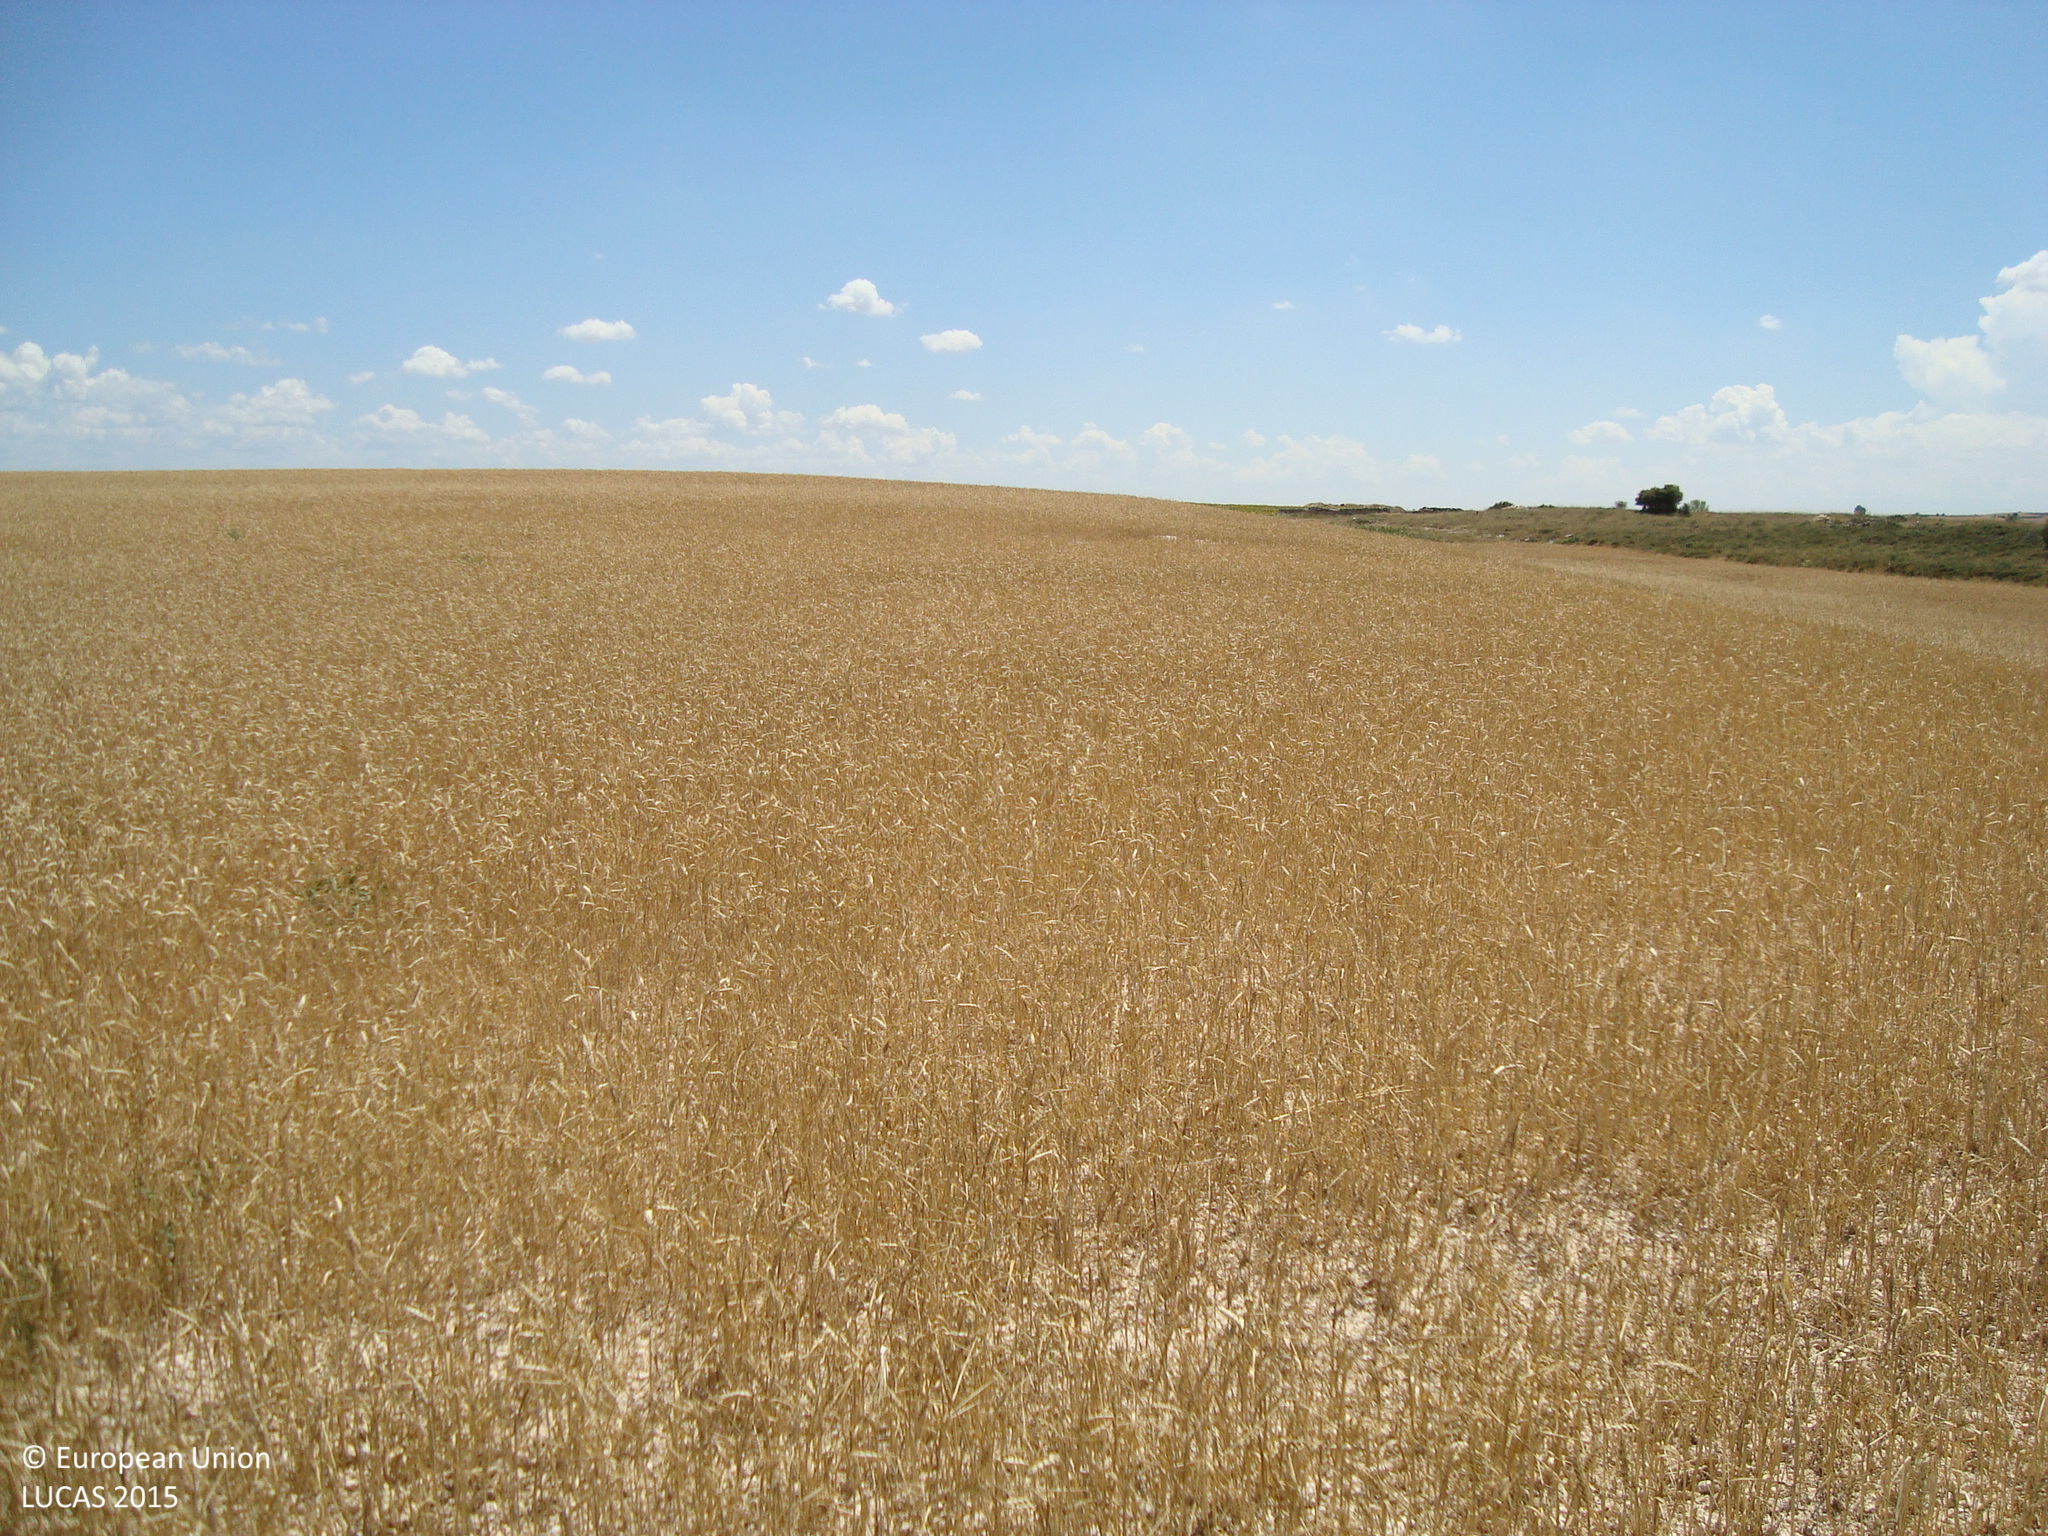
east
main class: Cropland
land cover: Common wheat
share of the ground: 50 - 75 %
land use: Agriculture (excluding fallow land and kitchen gardens)
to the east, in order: Common wheat; Sunflower; Grassland without tree/shrub cover
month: July
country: ES
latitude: 41.8704
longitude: -3.6572
